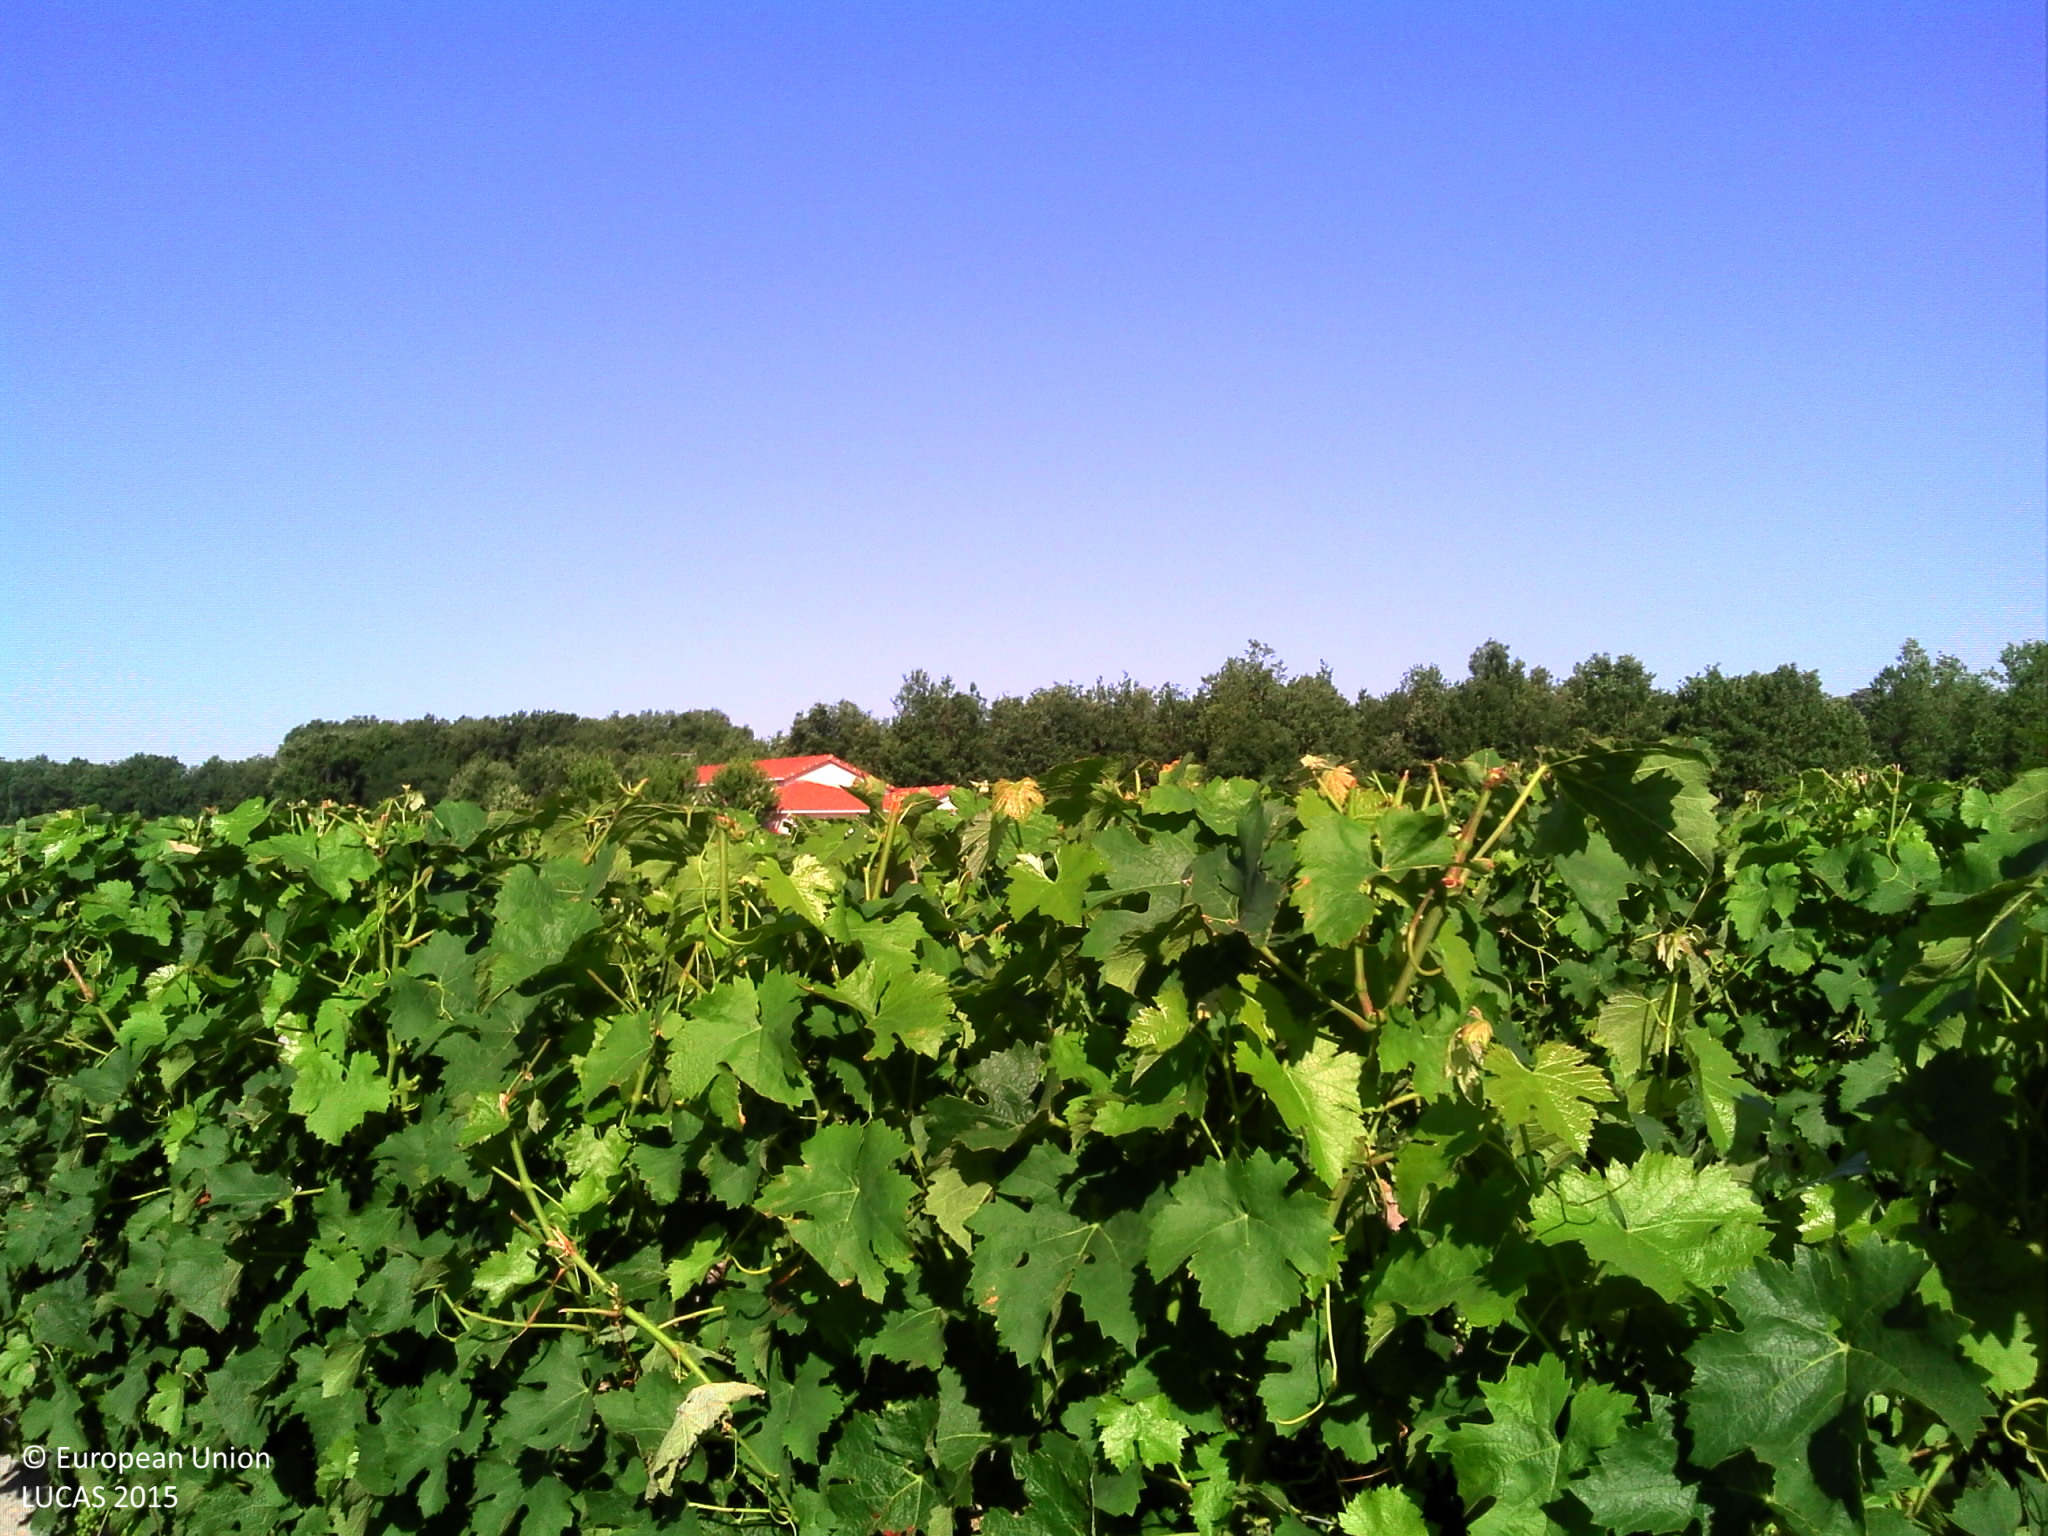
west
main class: Cropland
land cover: Vineyards
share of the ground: > 75 %
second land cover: Grassland without tree/shrub cover
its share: > 75 %
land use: Agriculture (excluding fallow land and kitchen gardens)
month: June
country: FR
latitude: 43.8643
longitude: 1.3782
